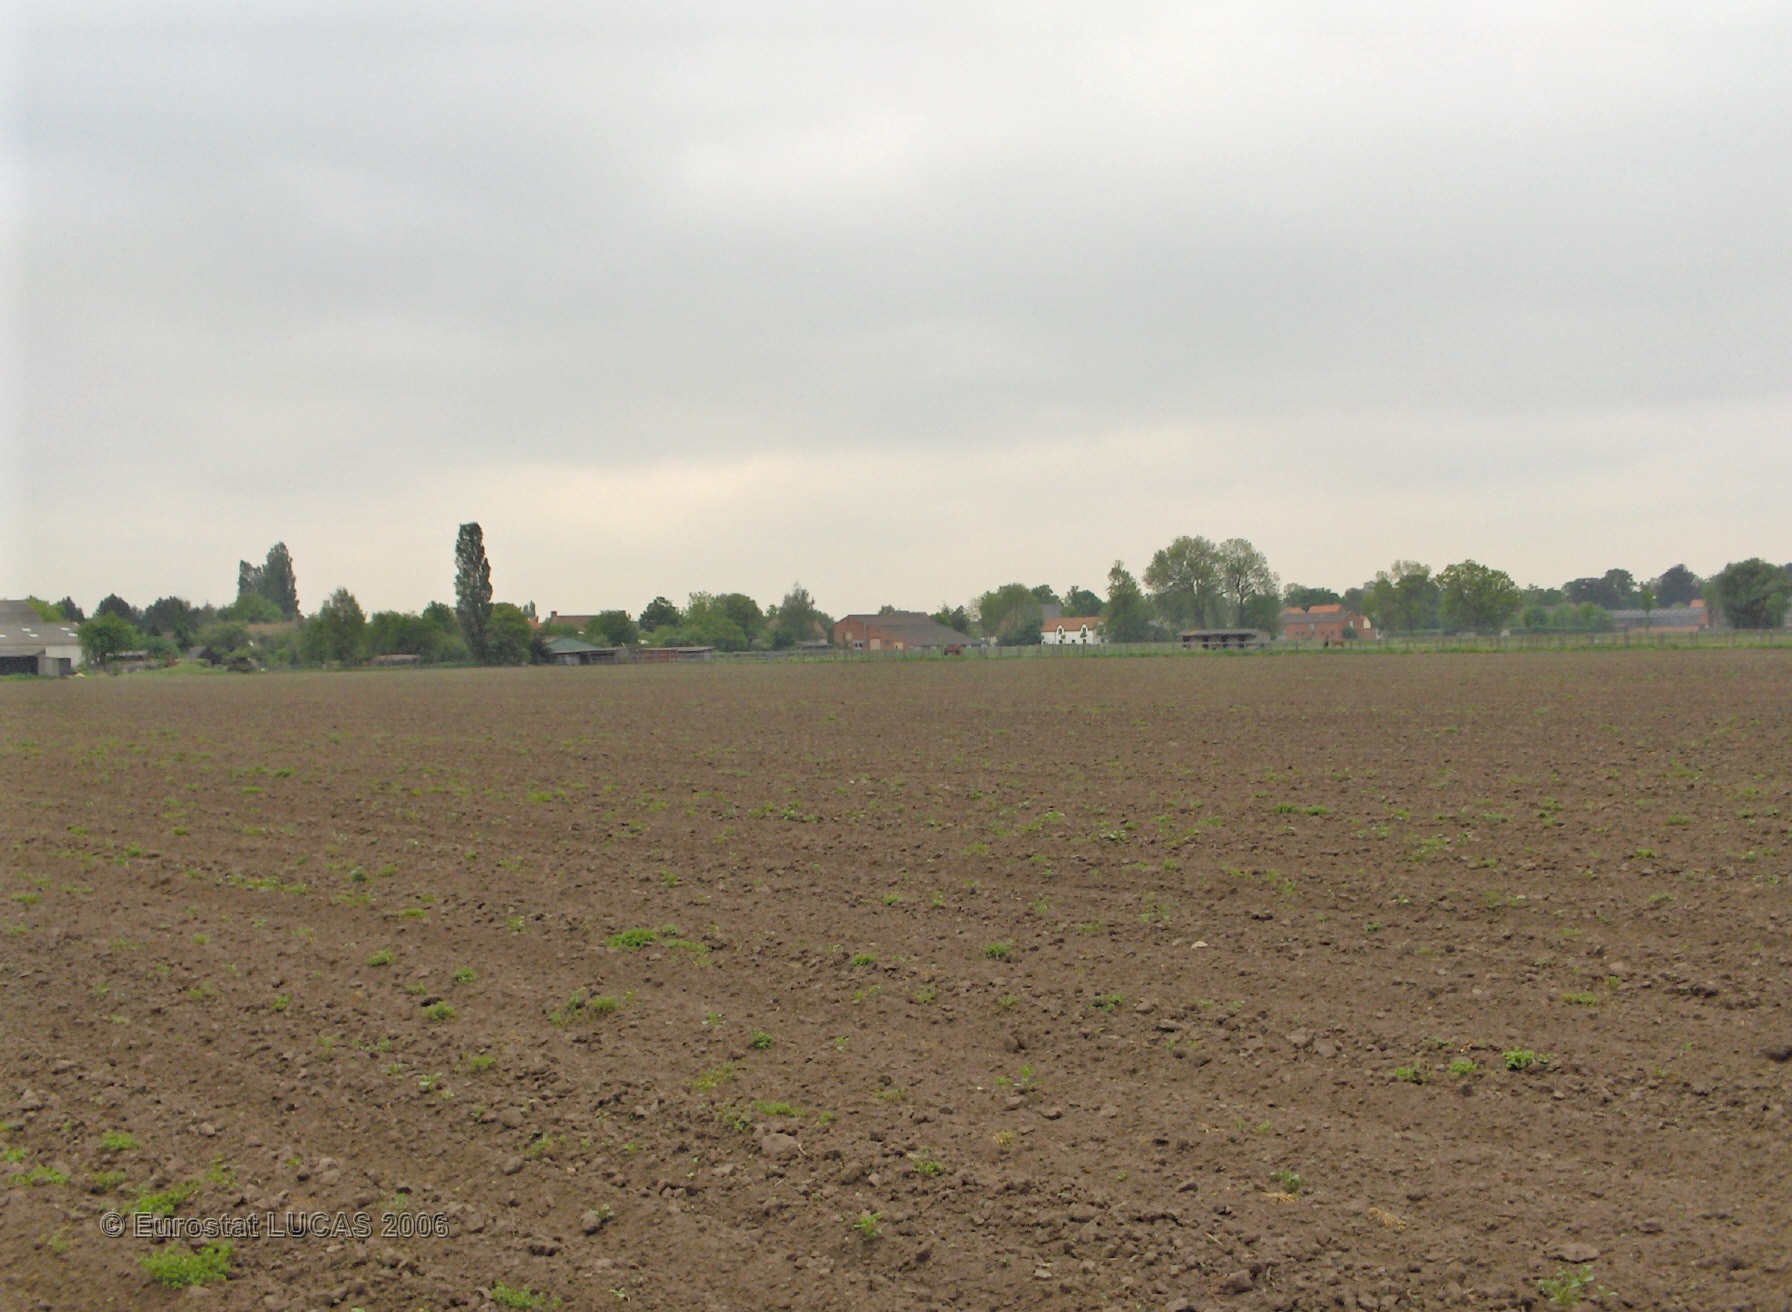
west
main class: Bare land
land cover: Bare land
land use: Agriculture (excluding fallow land and kitchen gardens)
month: May
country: BE
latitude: 51.3435
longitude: 4.3821
